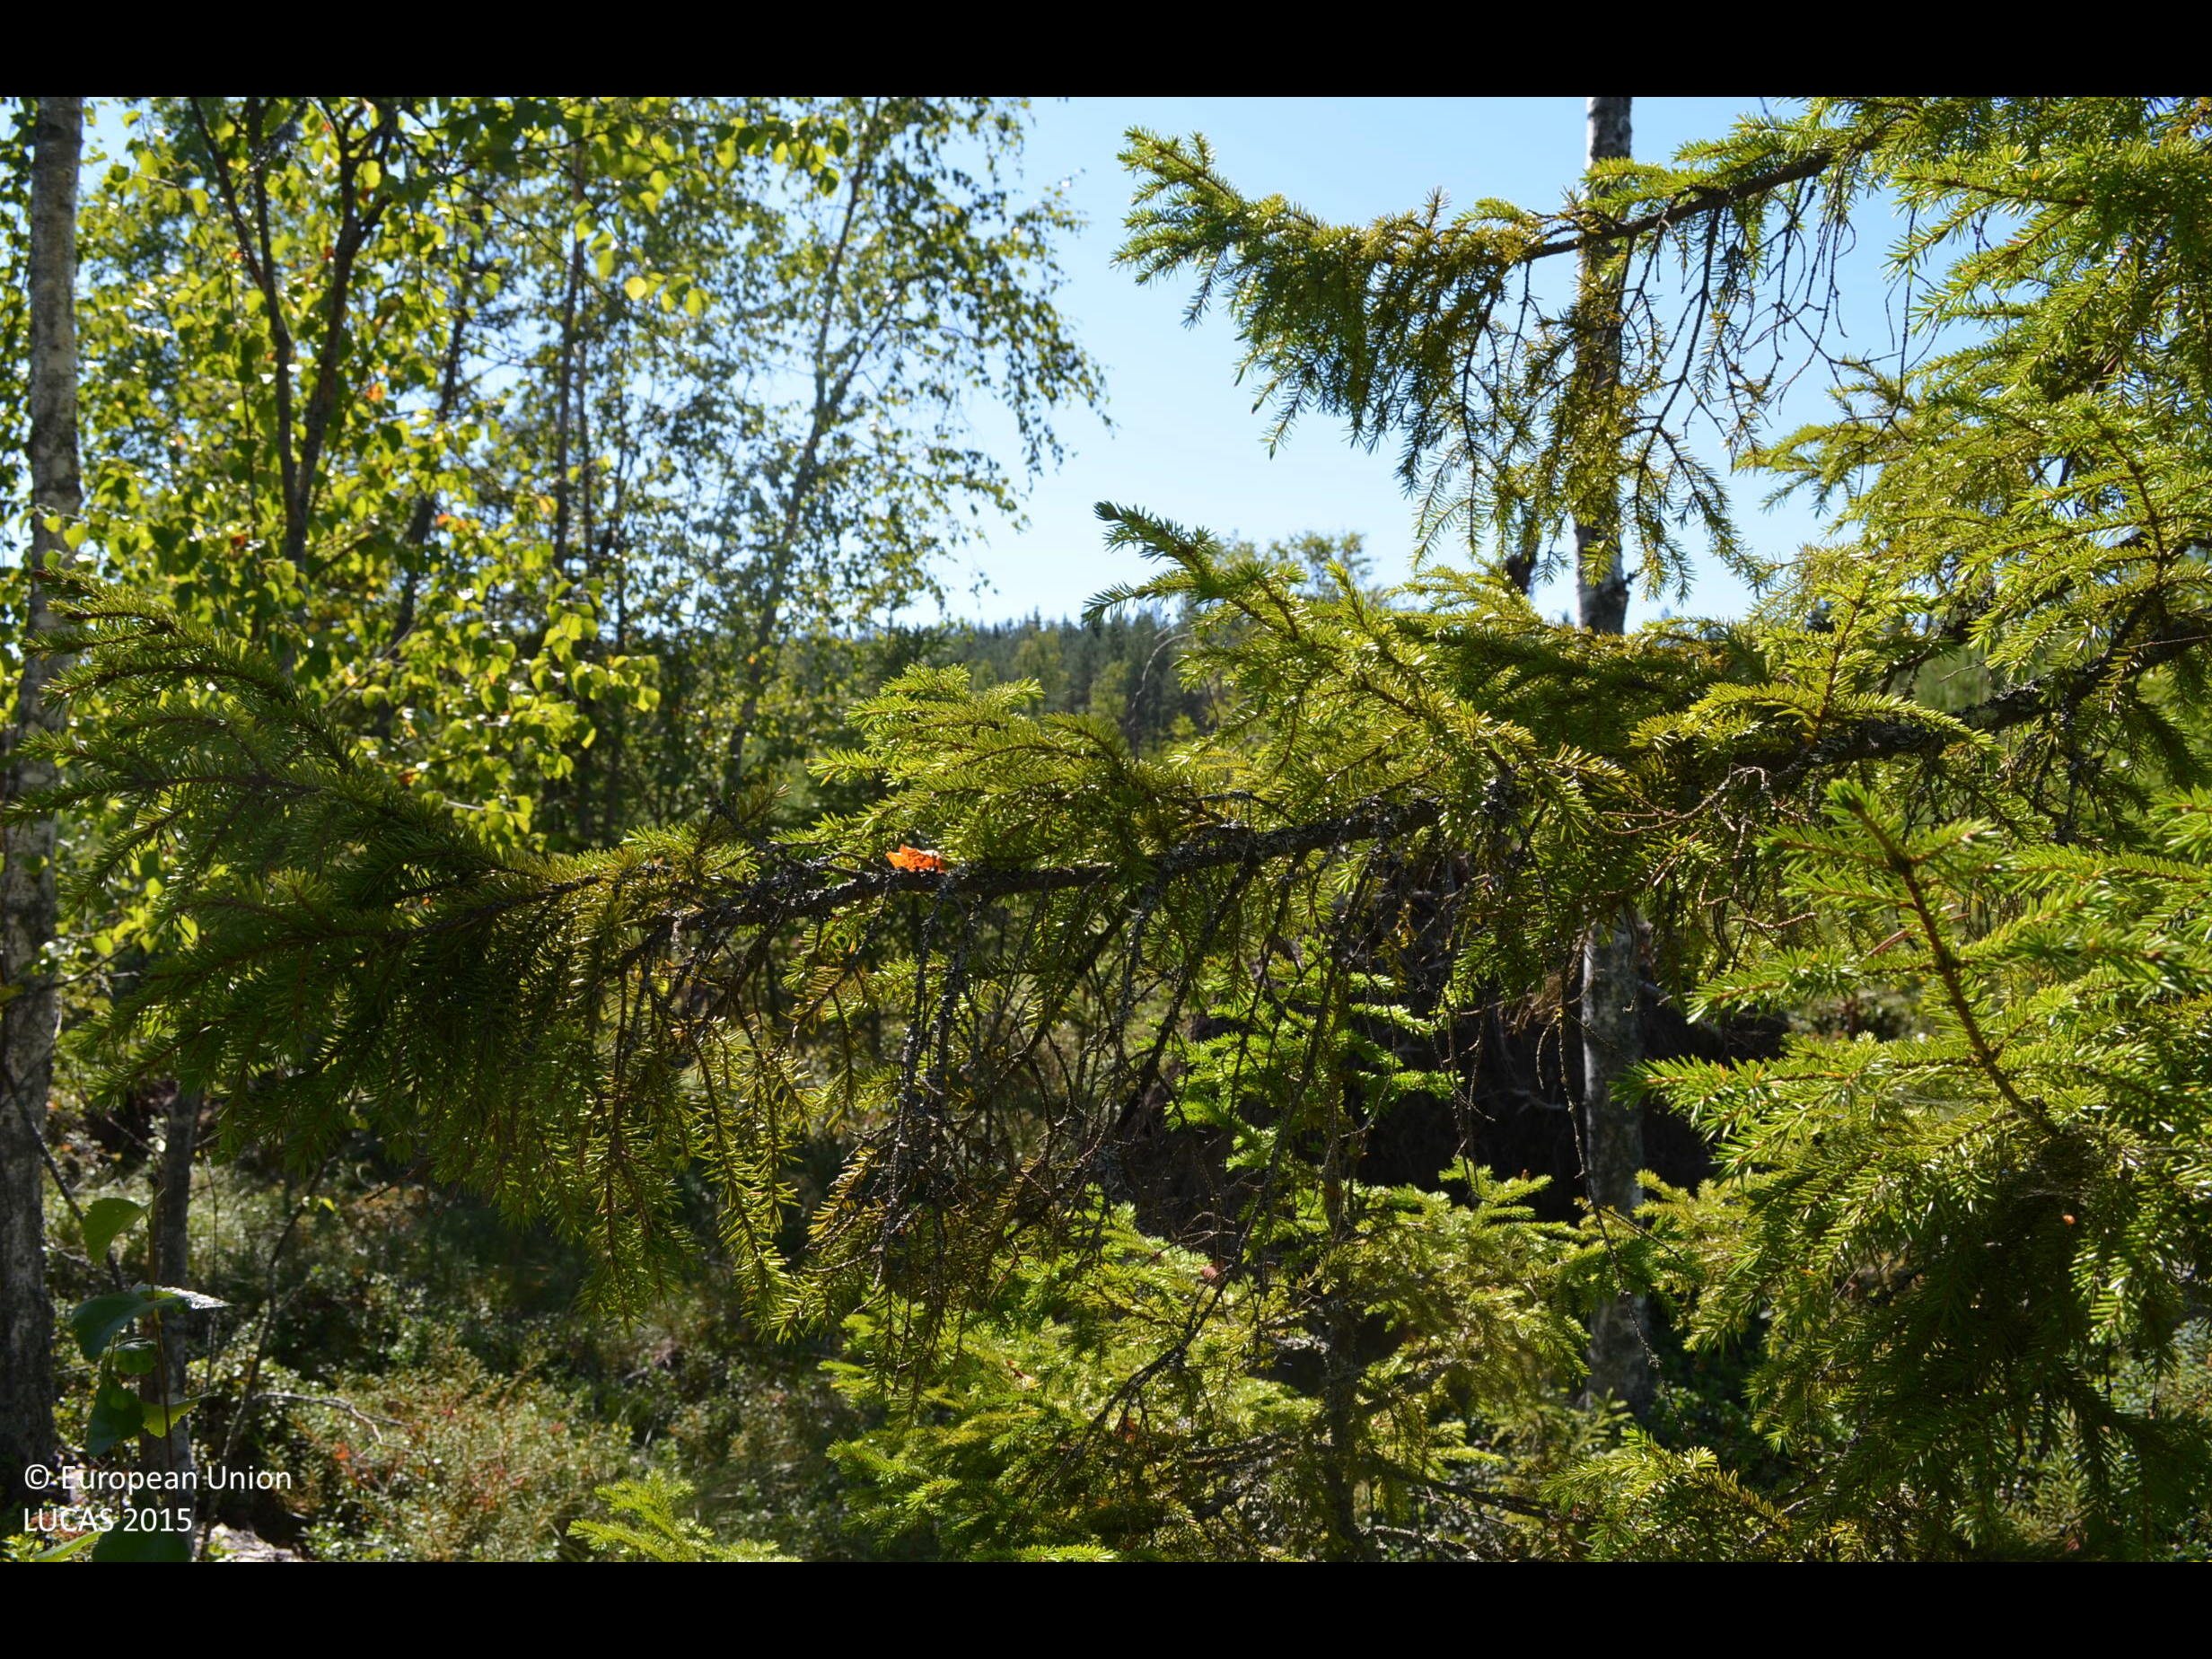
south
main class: Woodland
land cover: Other mixed woodland
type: boreal forest
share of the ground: 50 - 75 %
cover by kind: coniferous forest trees 50 %, shrubs 25 %, broadleaved forest trees 20 %, herbaceous plants 5 %
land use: Forestry
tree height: < 5 m
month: August
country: FI
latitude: 62.1486
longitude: 24.2676
